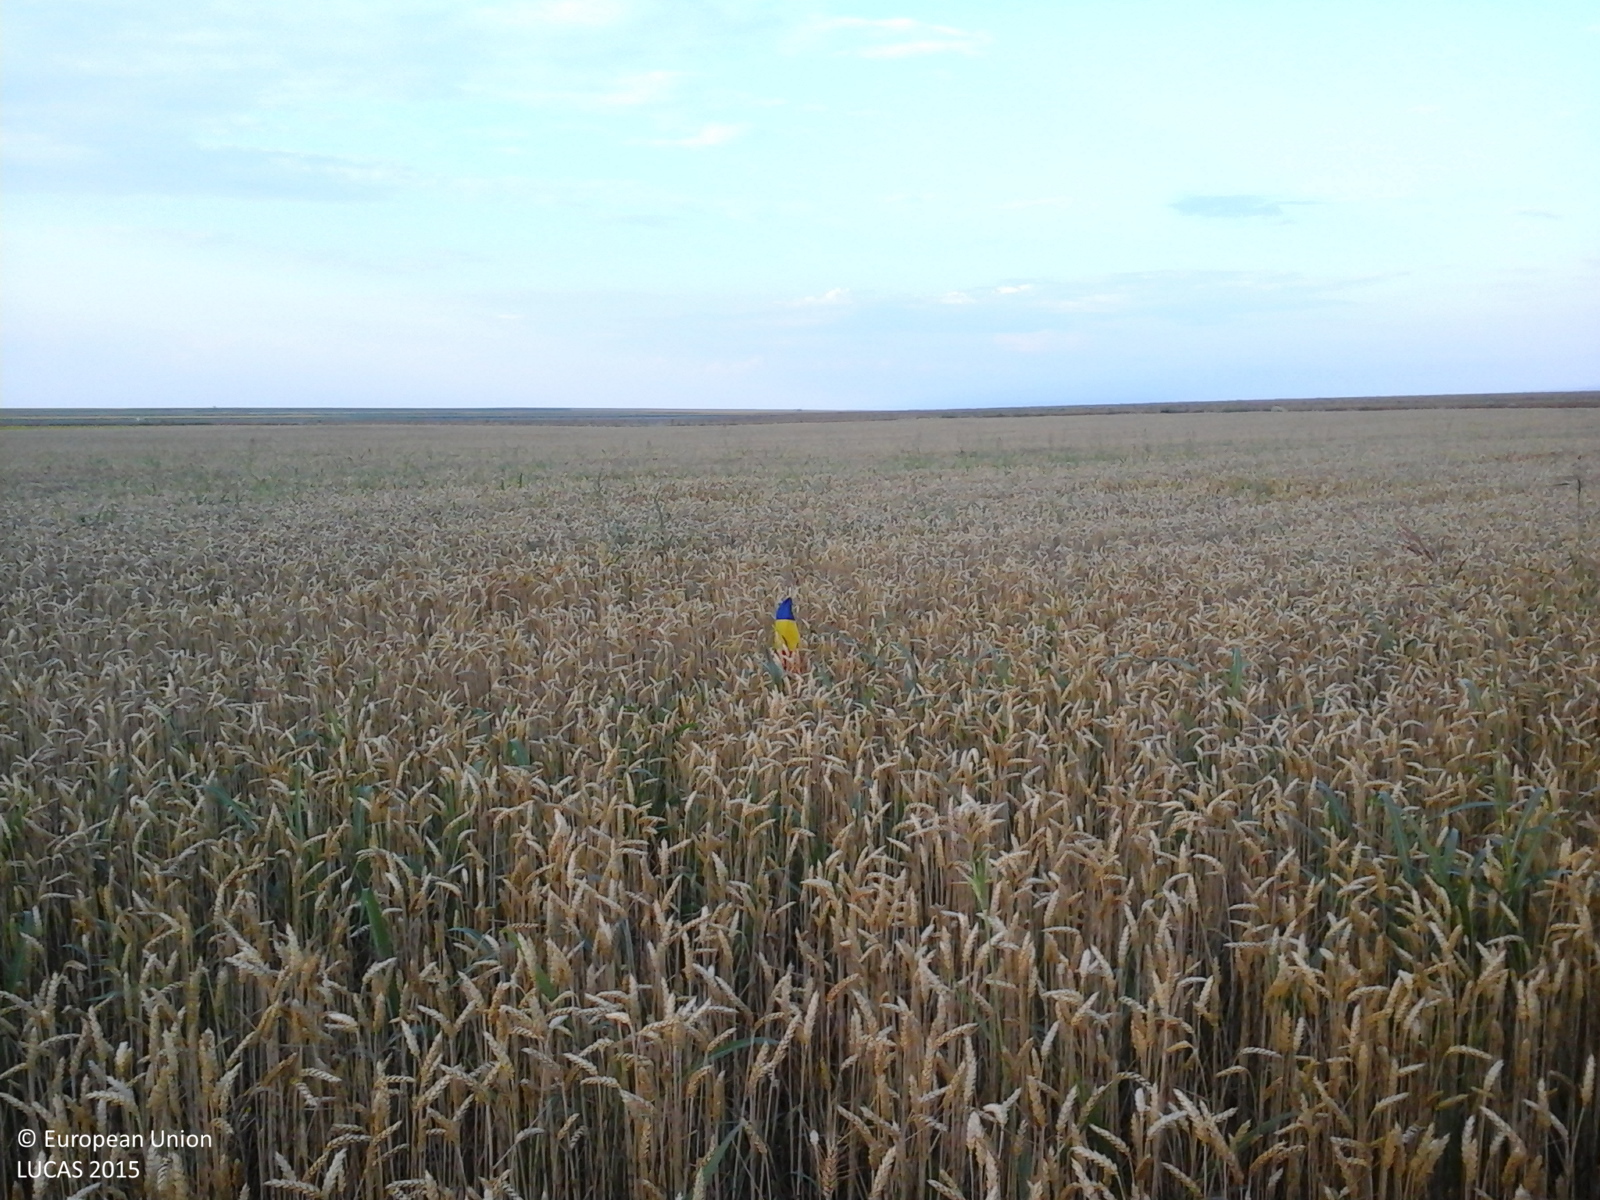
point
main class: Cropland
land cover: Common wheat
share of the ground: > 75 %
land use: Agriculture (excluding fallow land and kitchen gardens)
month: July
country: RO
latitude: 43.7578
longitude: 25.4219
